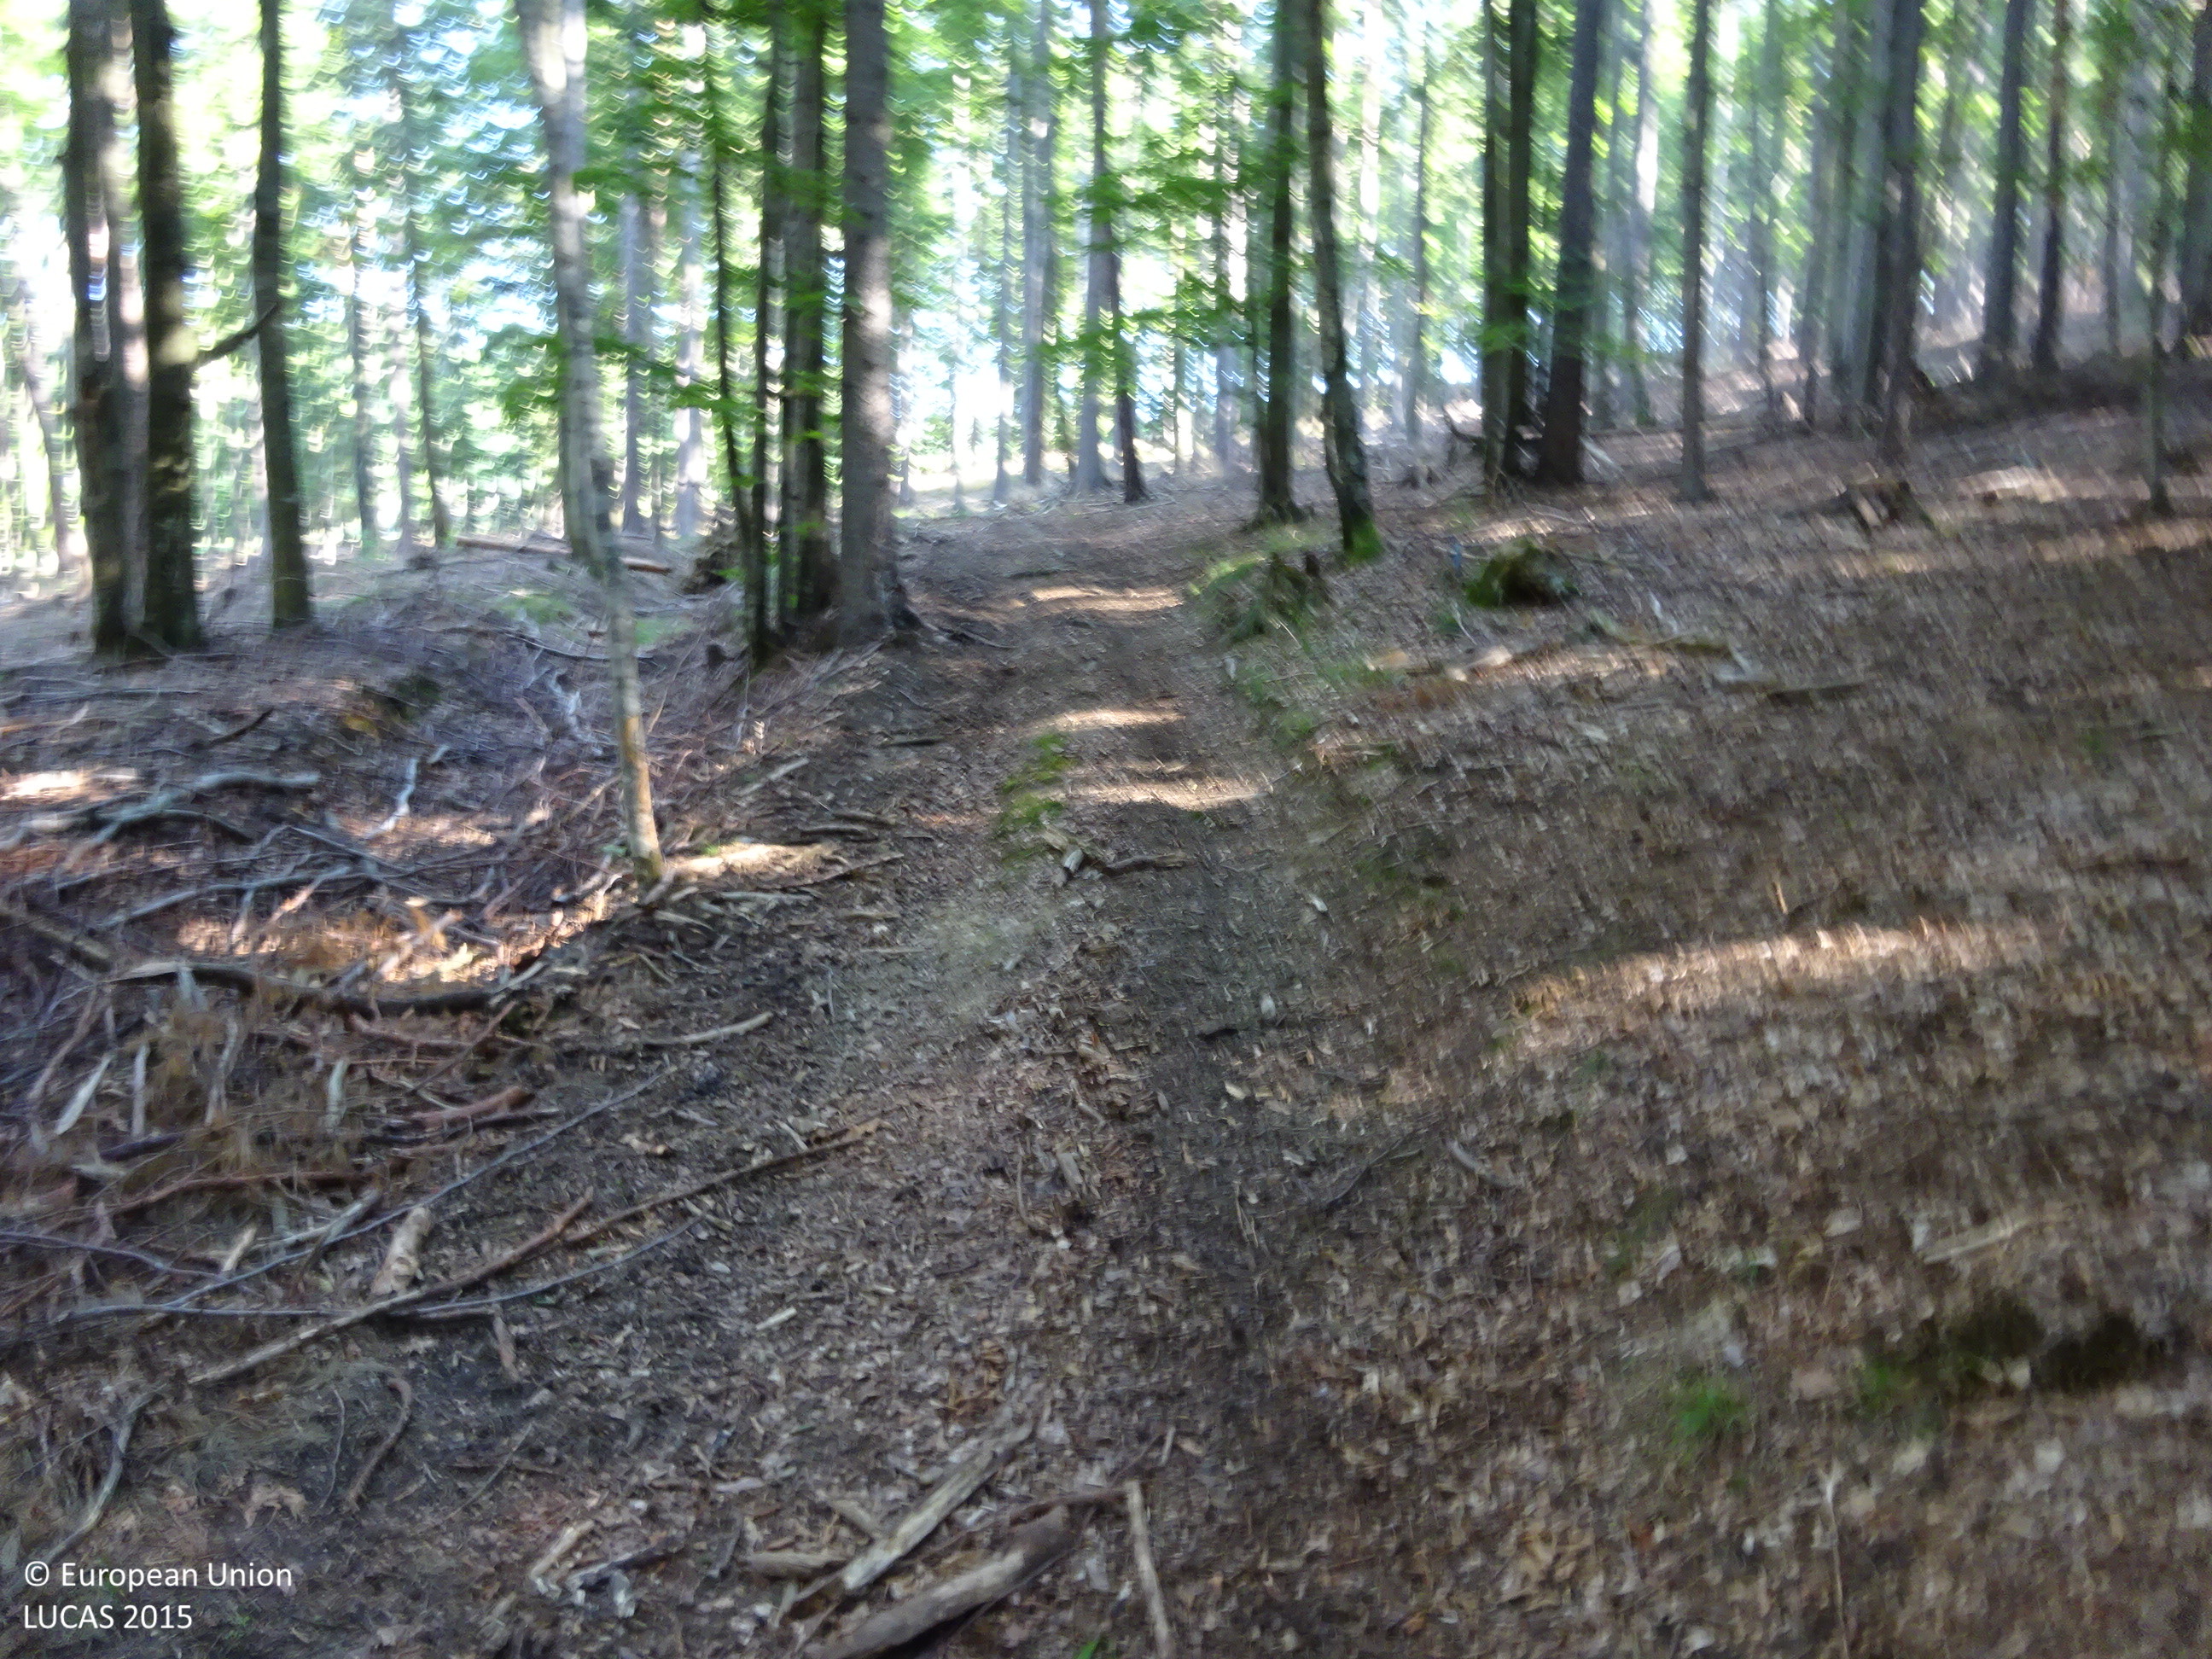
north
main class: Woodland
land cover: Pine dominated mixed woodland
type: hemiboreal forest and nemoral coniferous forest and mixed broadleaved-coniferous forest
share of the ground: > 75 %
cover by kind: broadleaved forest trees 75 %, coniferous forest trees 25 %
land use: Forestry
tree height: > 5 m
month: August
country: AT
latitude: 47.4207
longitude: 16.1396
